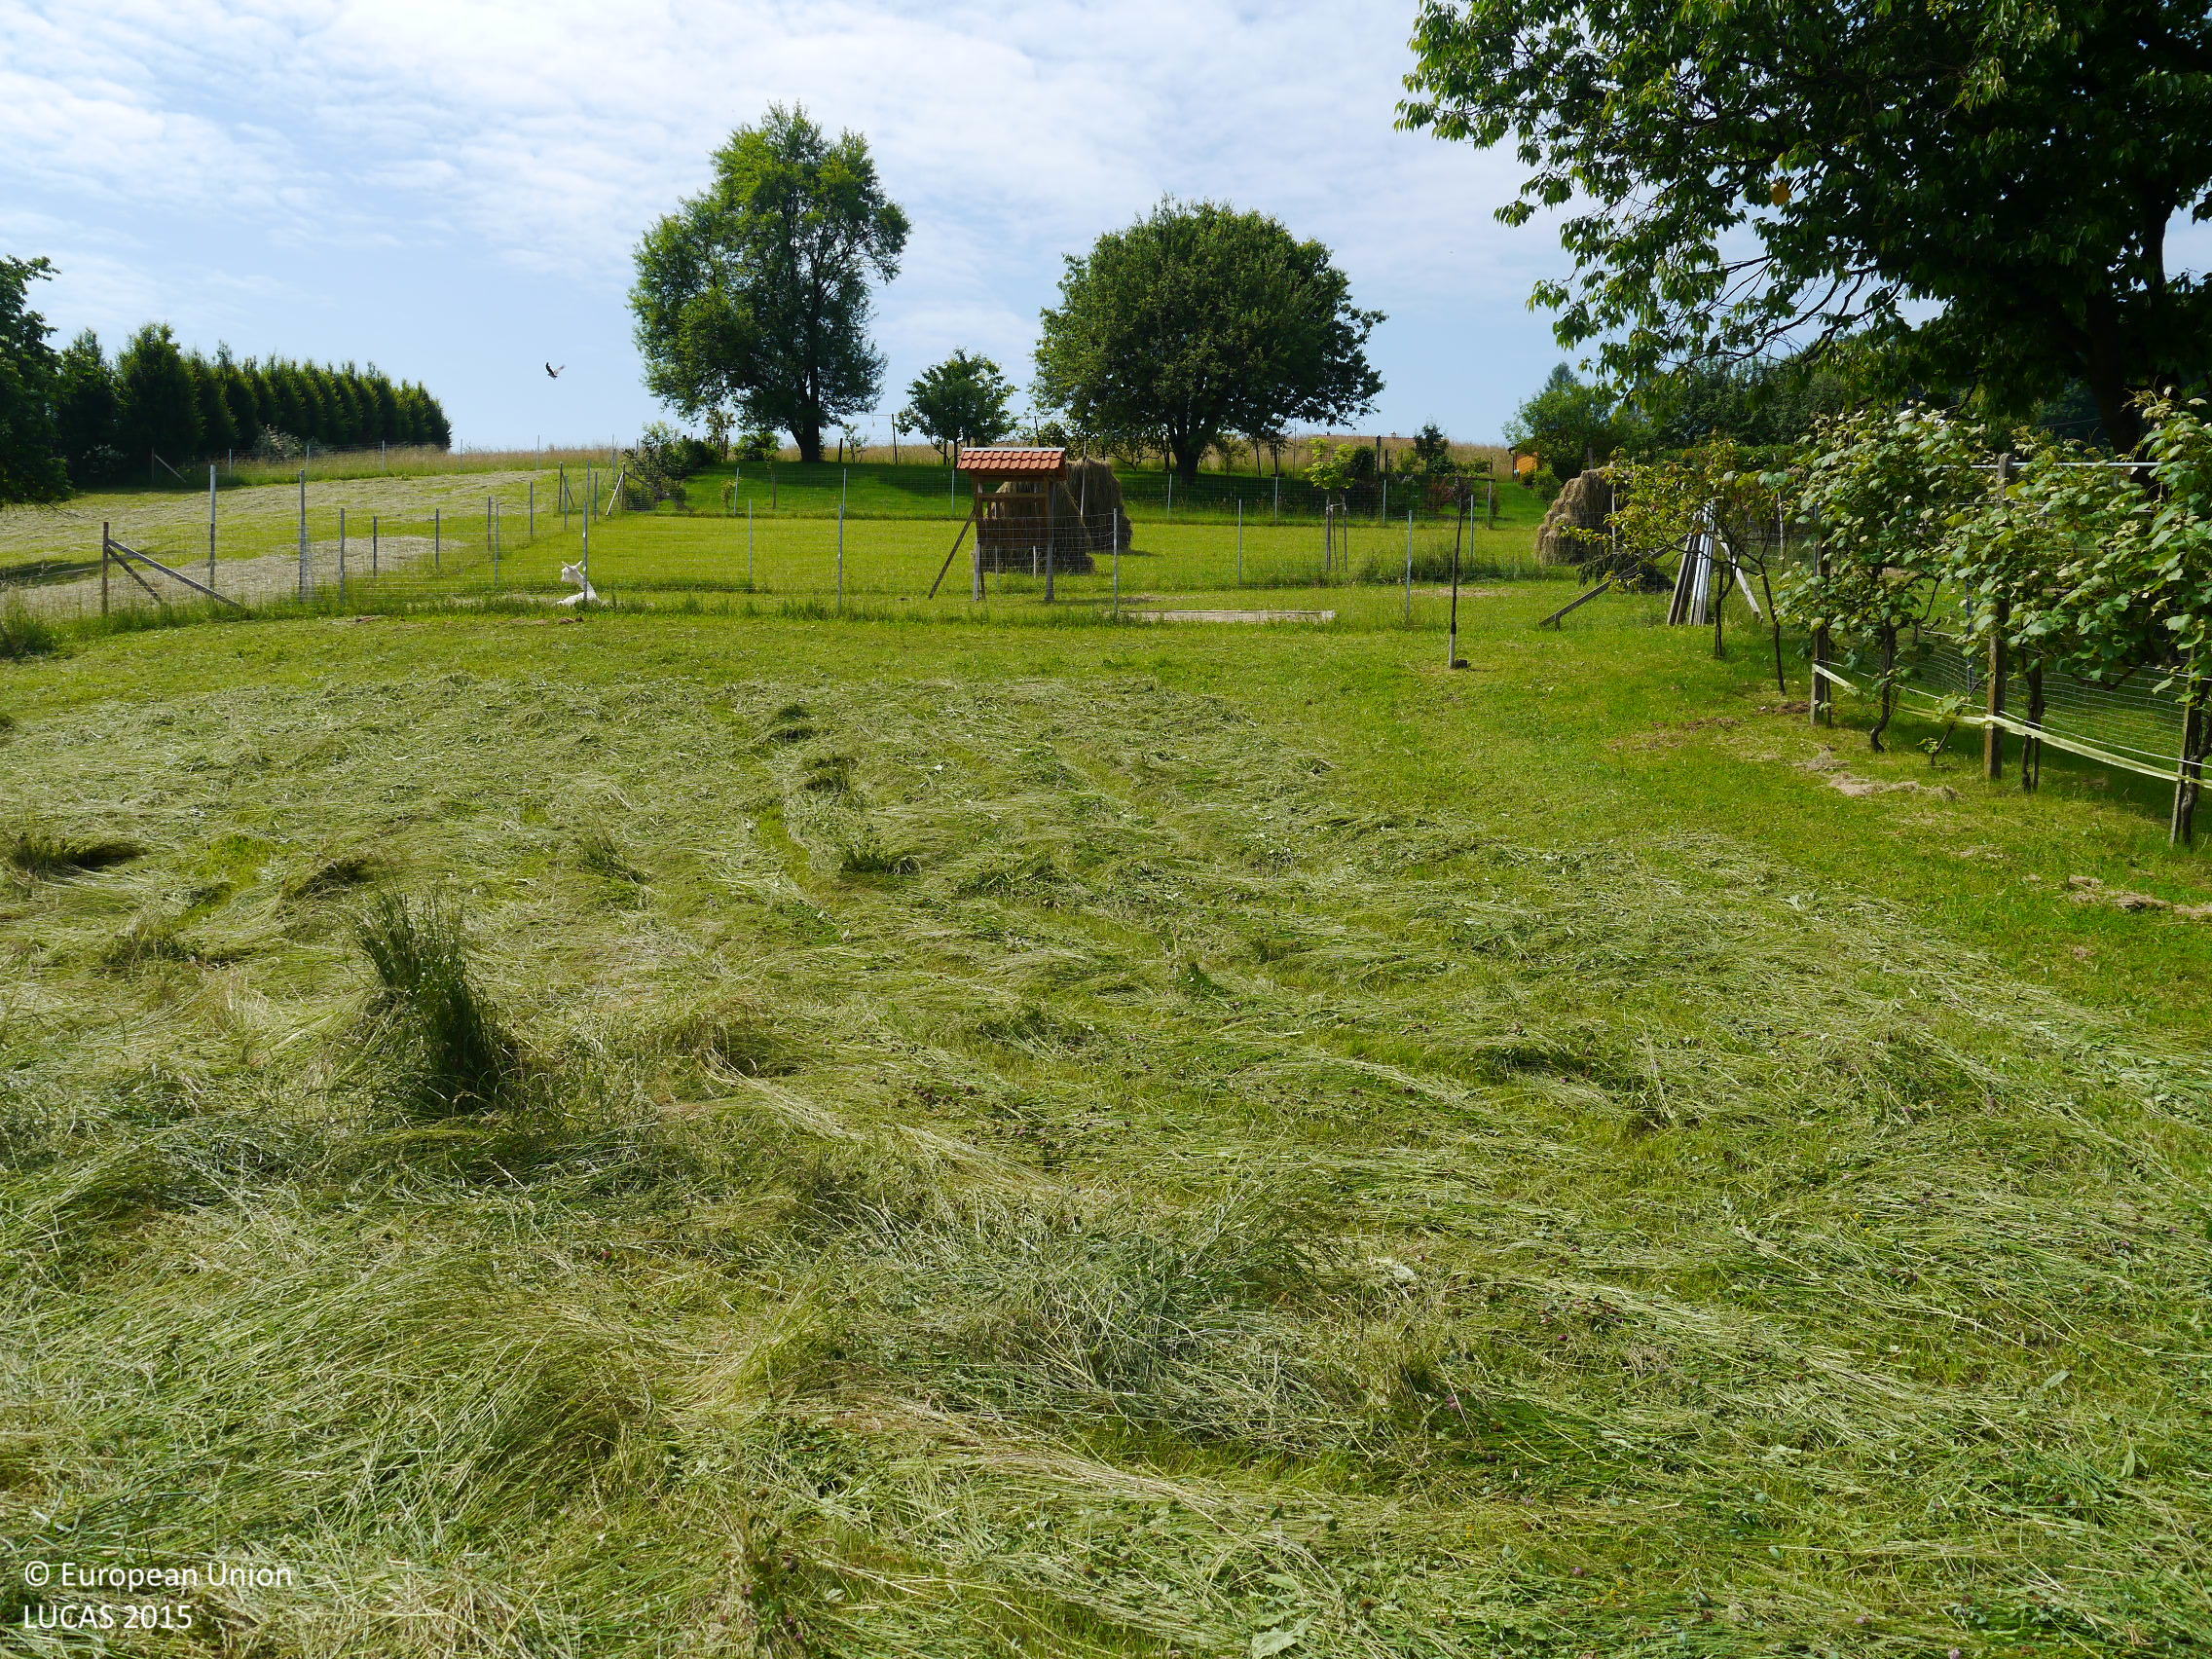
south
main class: Grassland
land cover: Grassland without tree/shrub cover
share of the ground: > 75 %
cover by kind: herbaceous plants 100 %
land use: Agriculture (excluding fallow land and kitchen gardens)
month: June
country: AT
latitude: 46.9027
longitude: 15.7105
